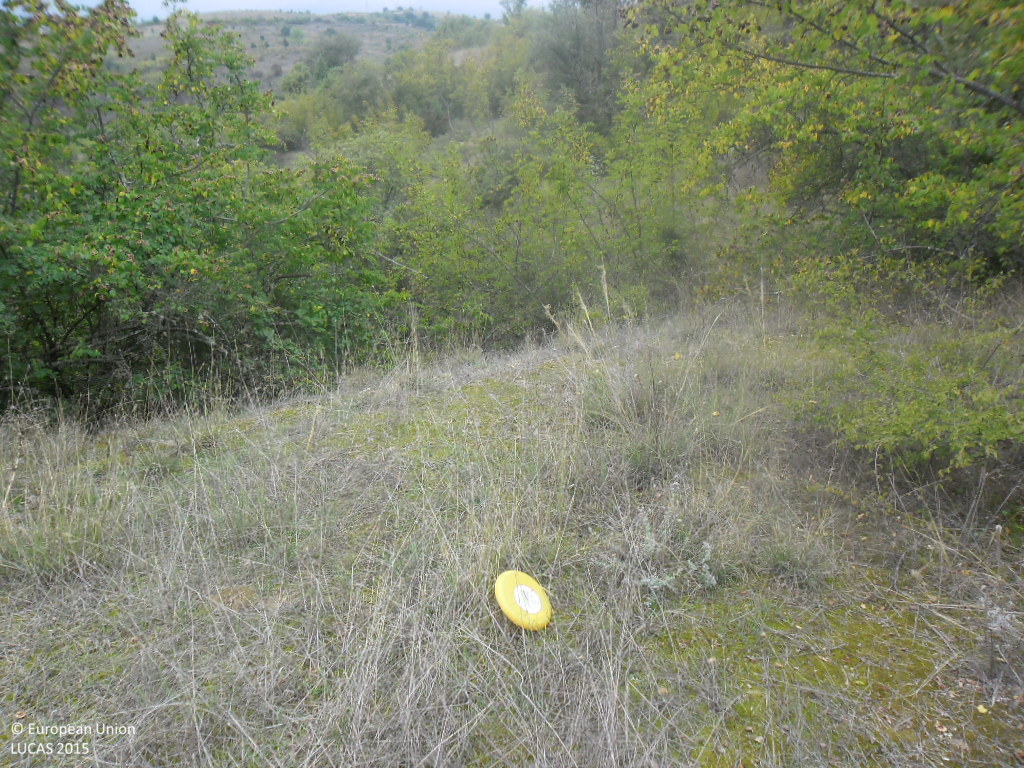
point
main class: Shrubland
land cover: Shrubland with sparse tree cover
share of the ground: 50 - 75 %
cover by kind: shrubs 70 %, herbaceous plants 25 %, broadleaved forest trees 5 %
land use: Semi-natural and natural areas not in use
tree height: < 5 m
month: October
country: BG
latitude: 41.3960
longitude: 23.3810
